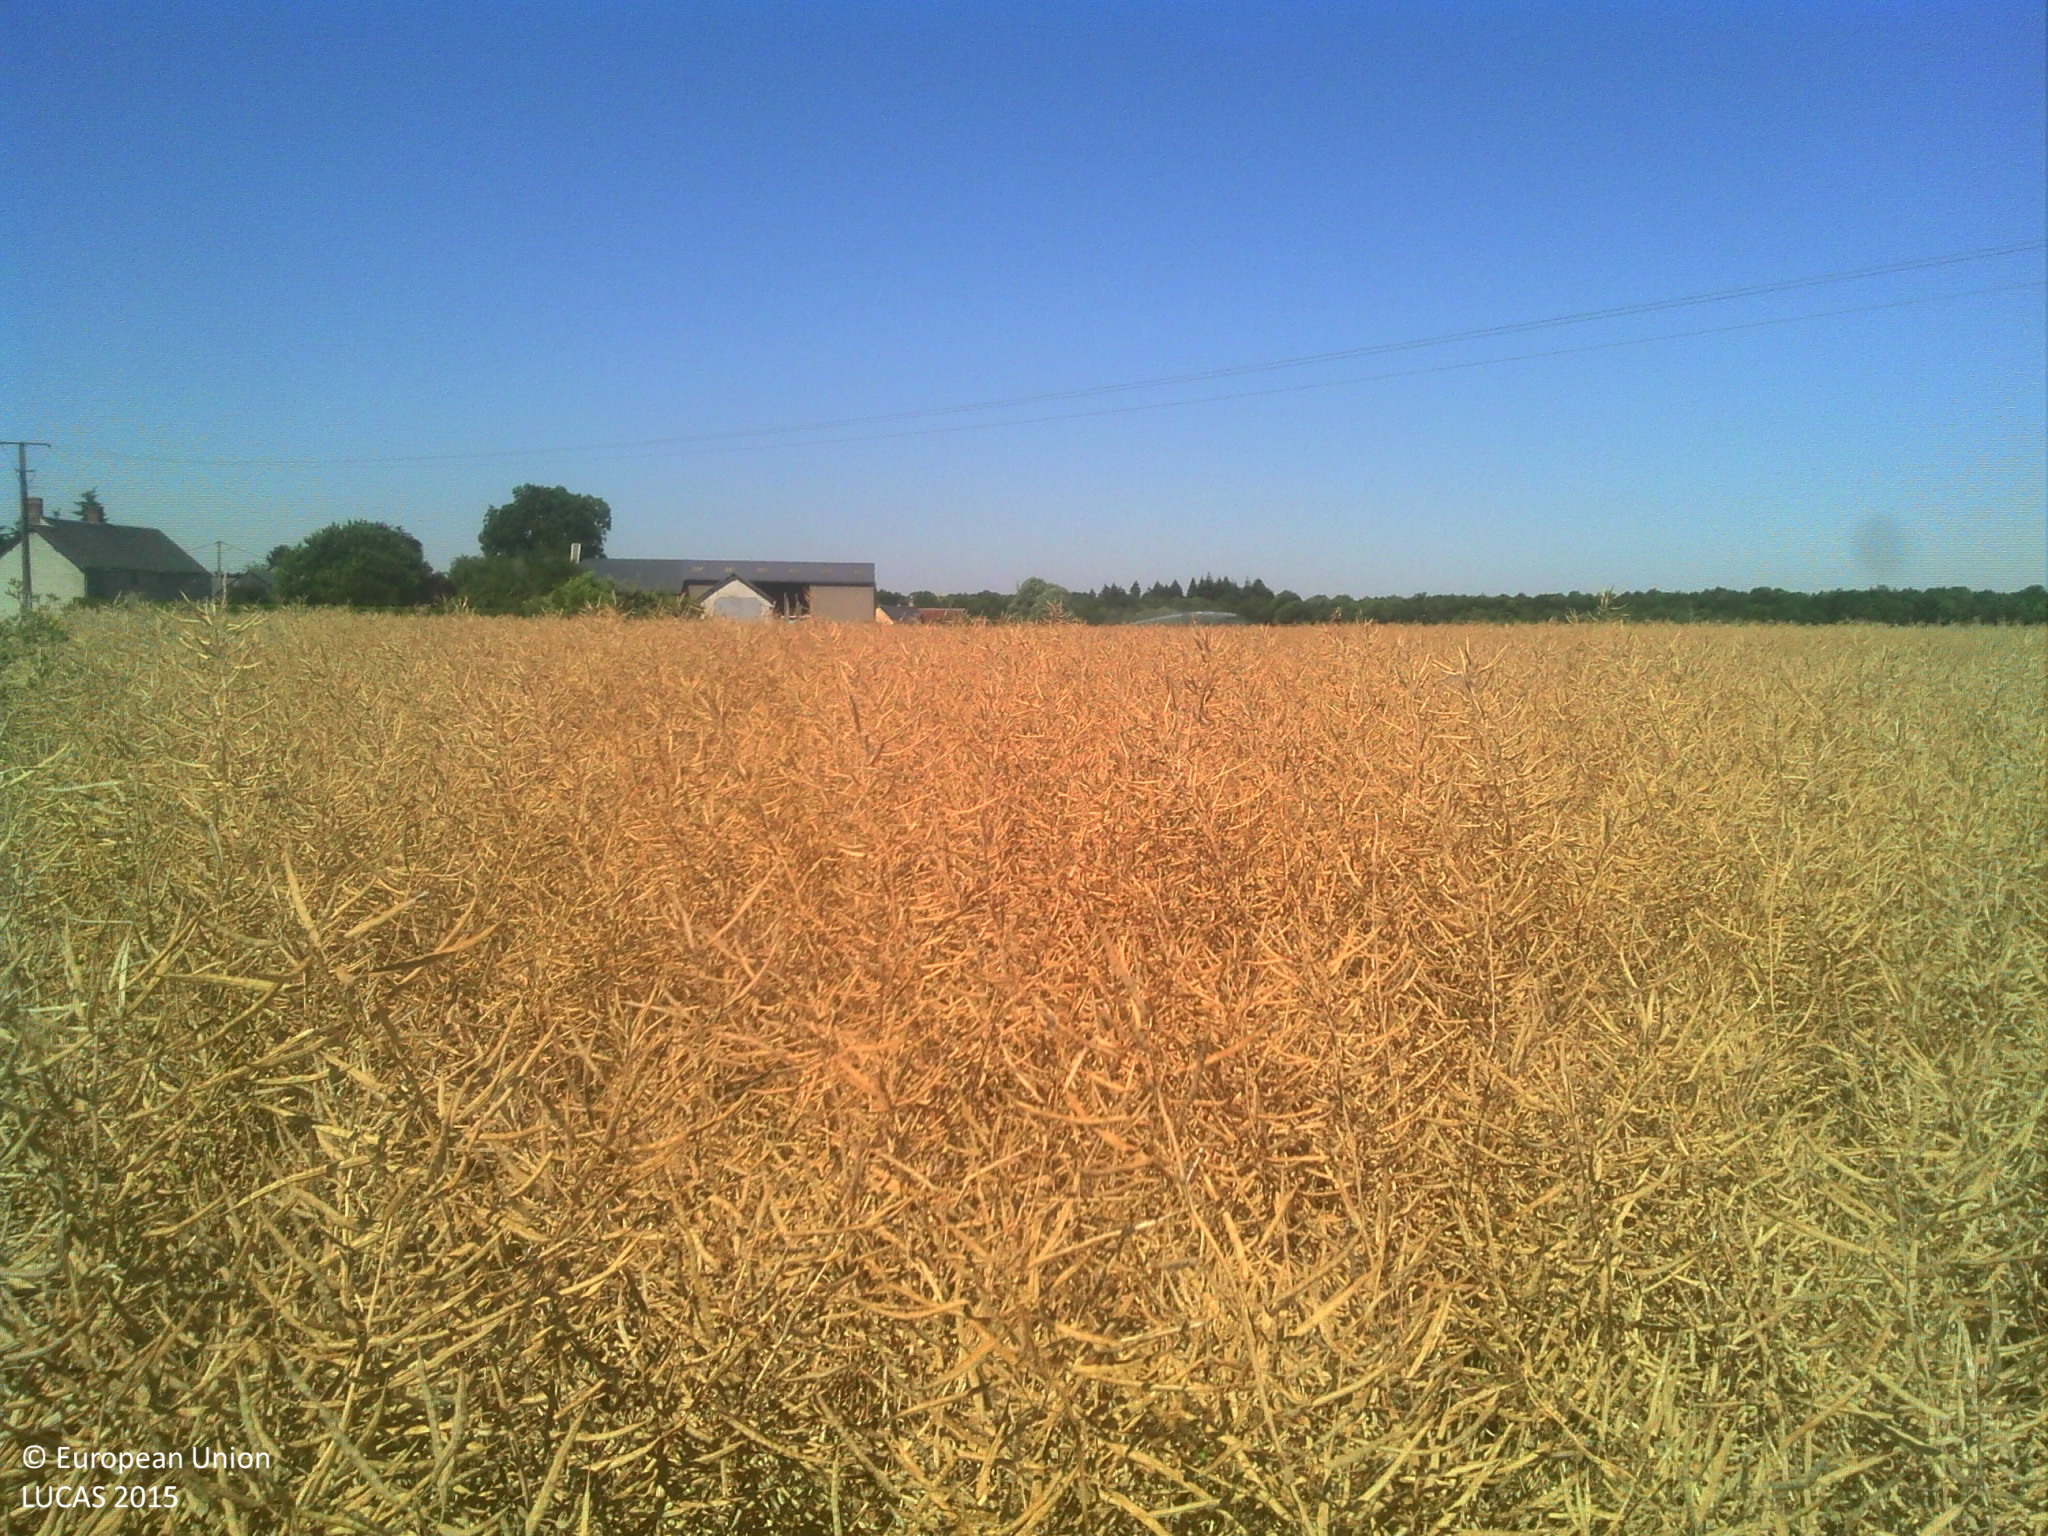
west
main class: Cropland
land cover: Rape and turnip rape
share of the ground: > 75 %
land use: Agriculture (excluding fallow land and kitchen gardens)
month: July
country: FR
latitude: 48.0087
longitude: 1.3372
